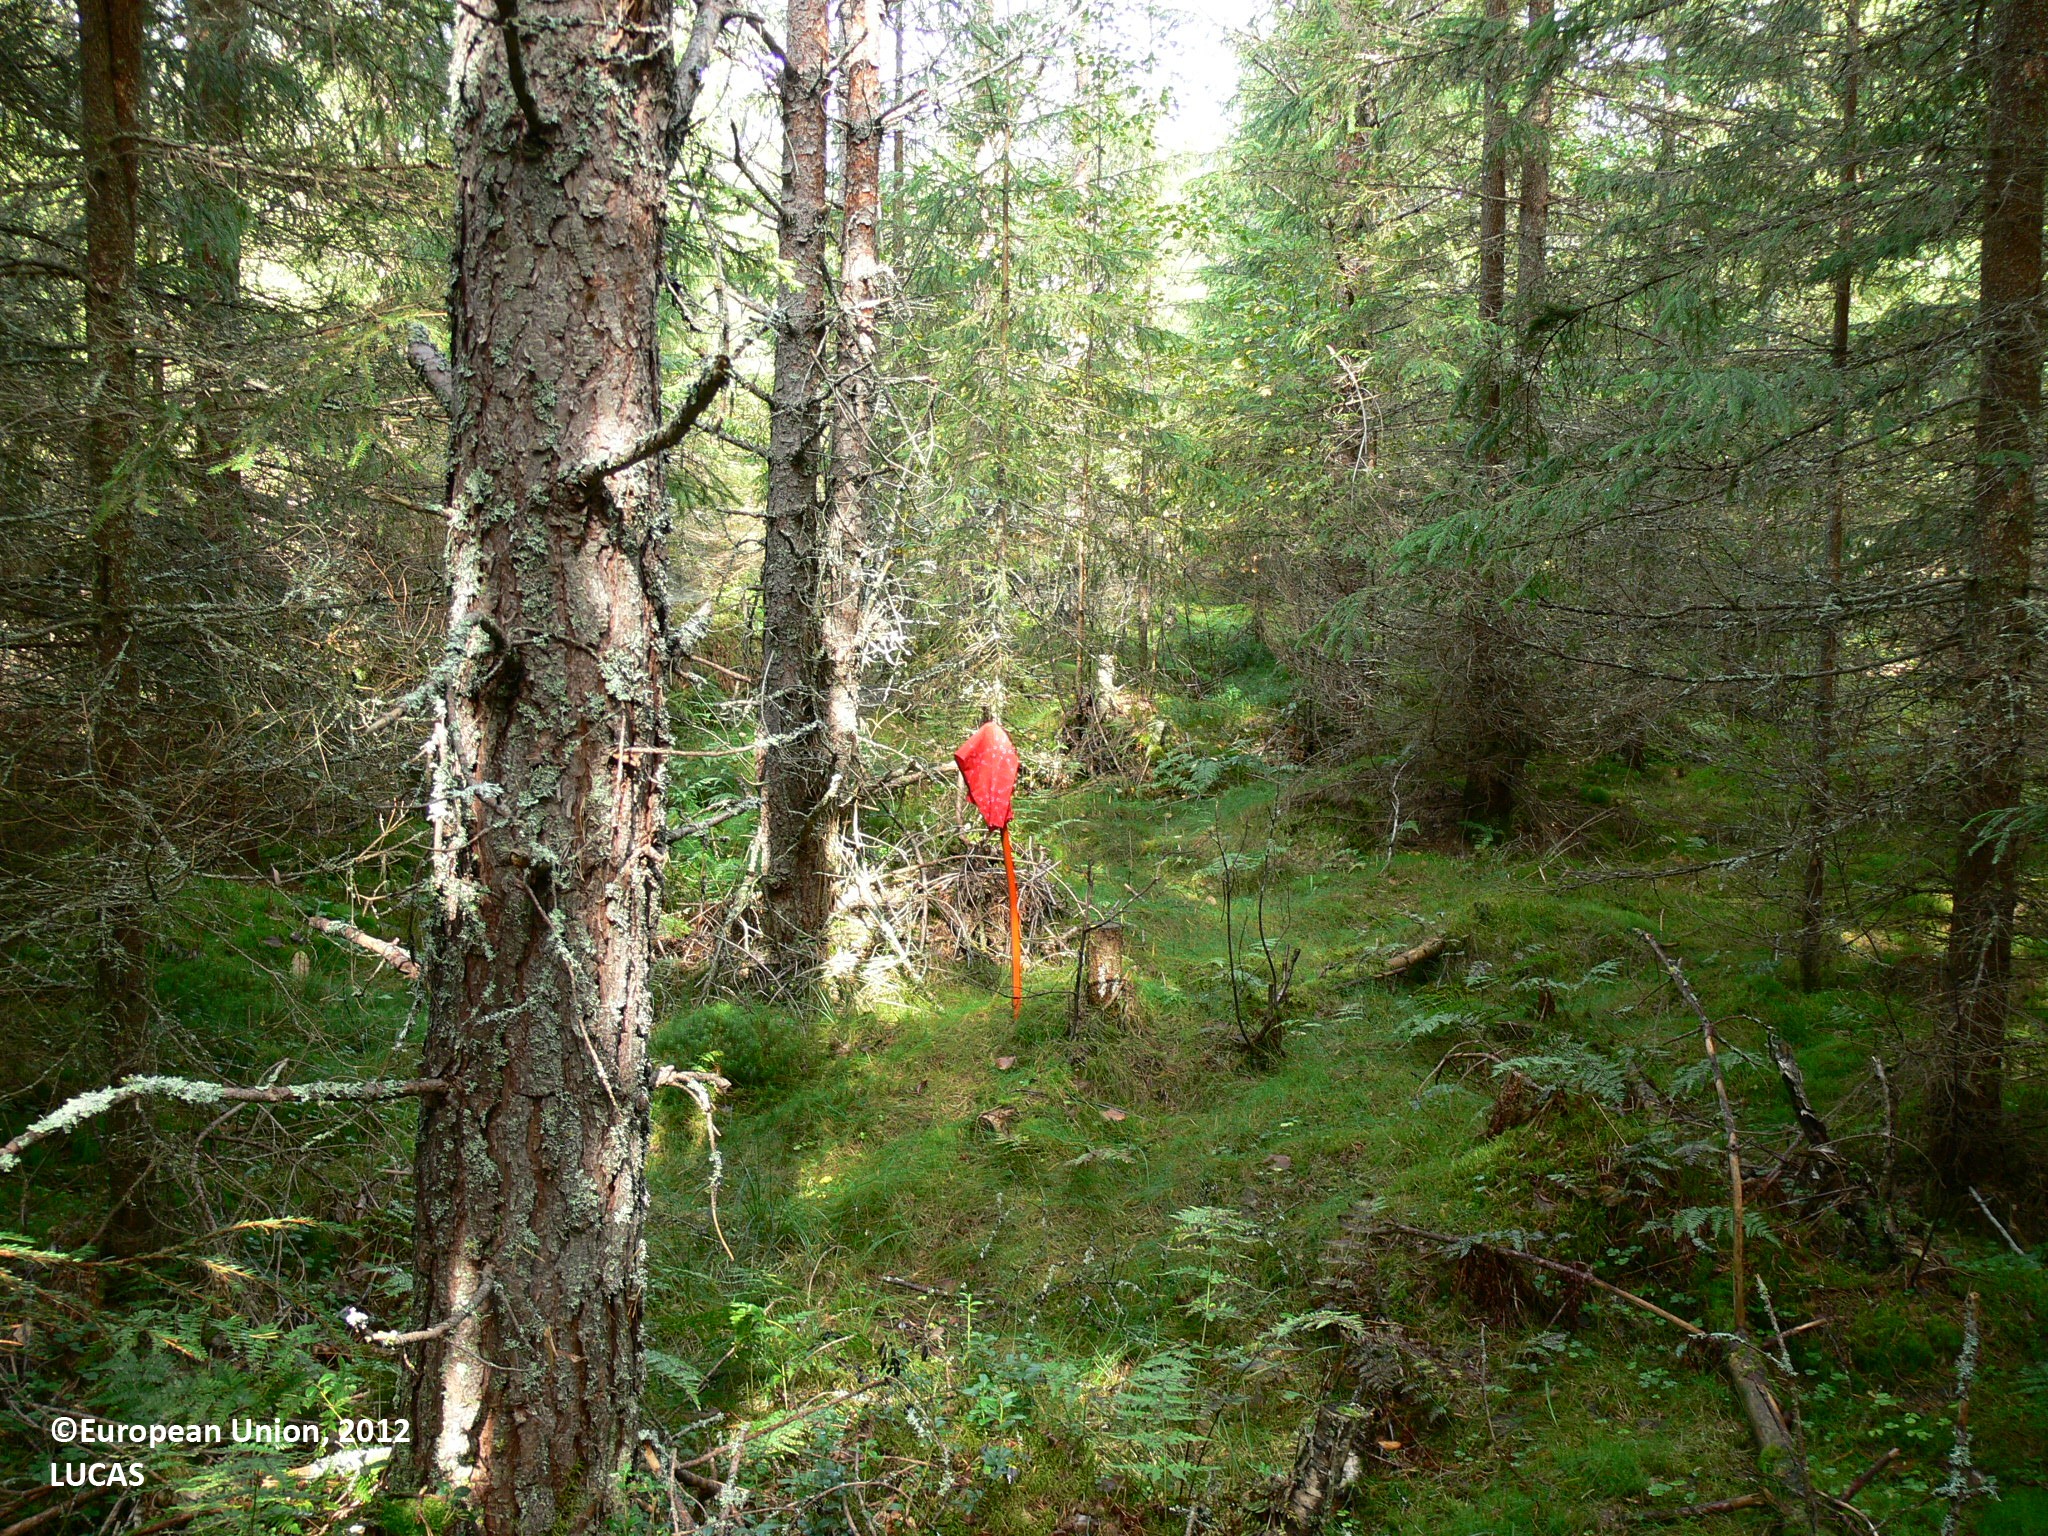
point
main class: Woodland
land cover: Other coniferous woodland
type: boreal forest
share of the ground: > 75 %
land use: Forestry
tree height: > 5 m
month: August
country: FI
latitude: 61.7170
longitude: 29.8434
